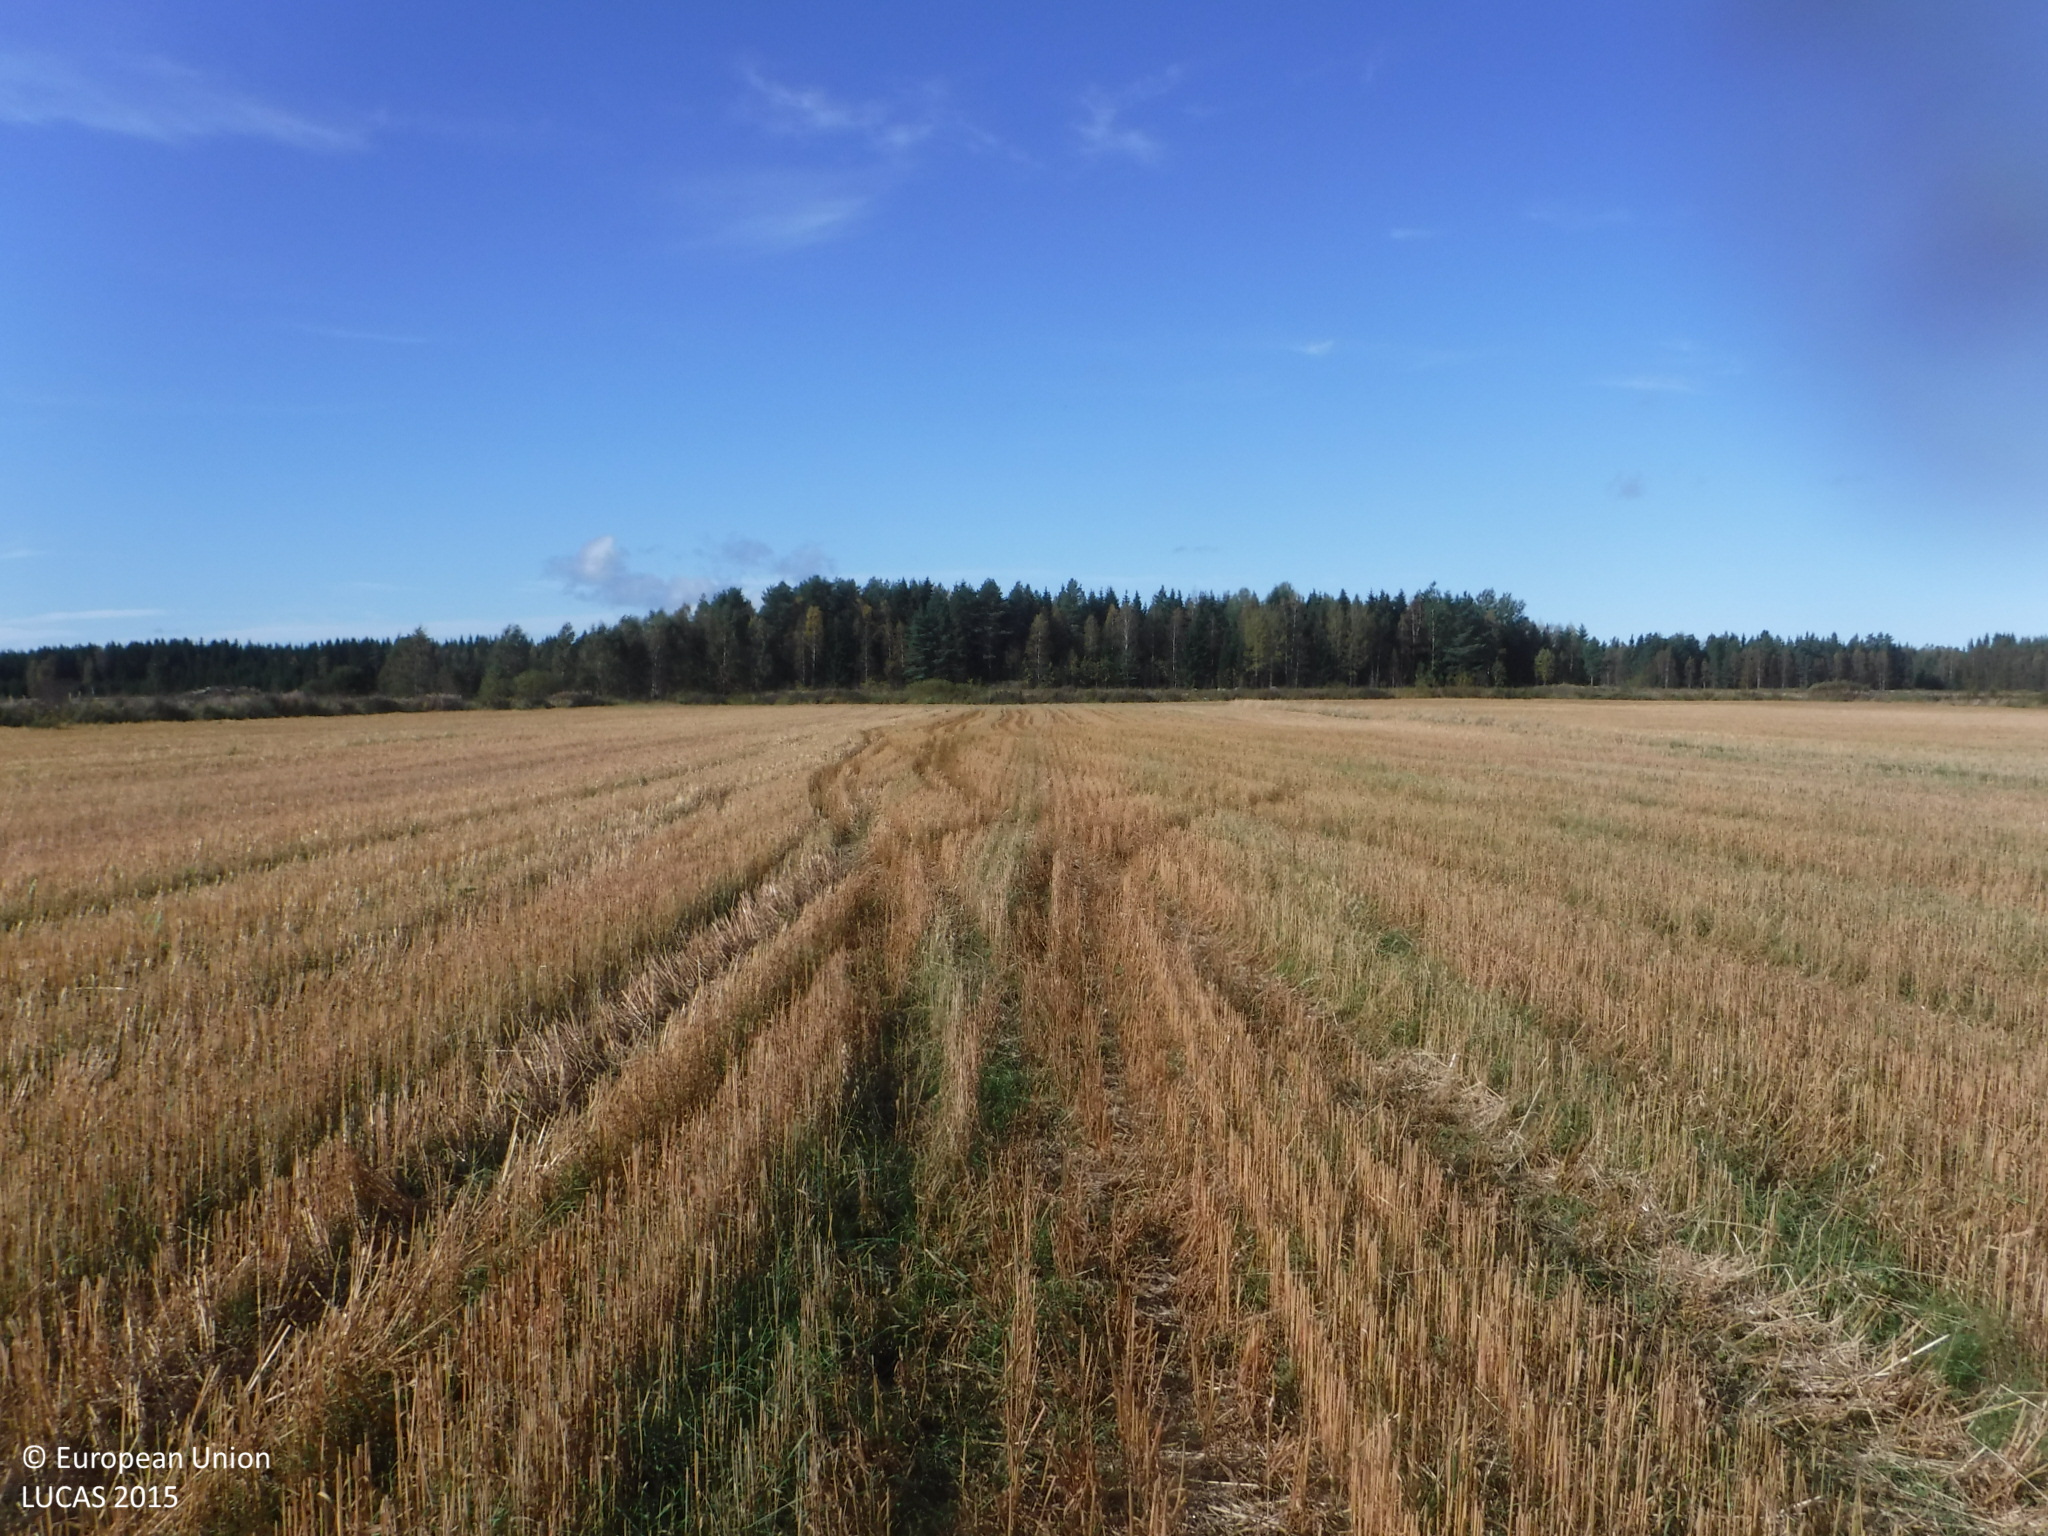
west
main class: Cropland
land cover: Oats
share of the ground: 50 - 75 %
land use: Agriculture (excluding fallow land and kitchen gardens)
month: September
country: FI
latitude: 62.1135
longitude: 21.5264
